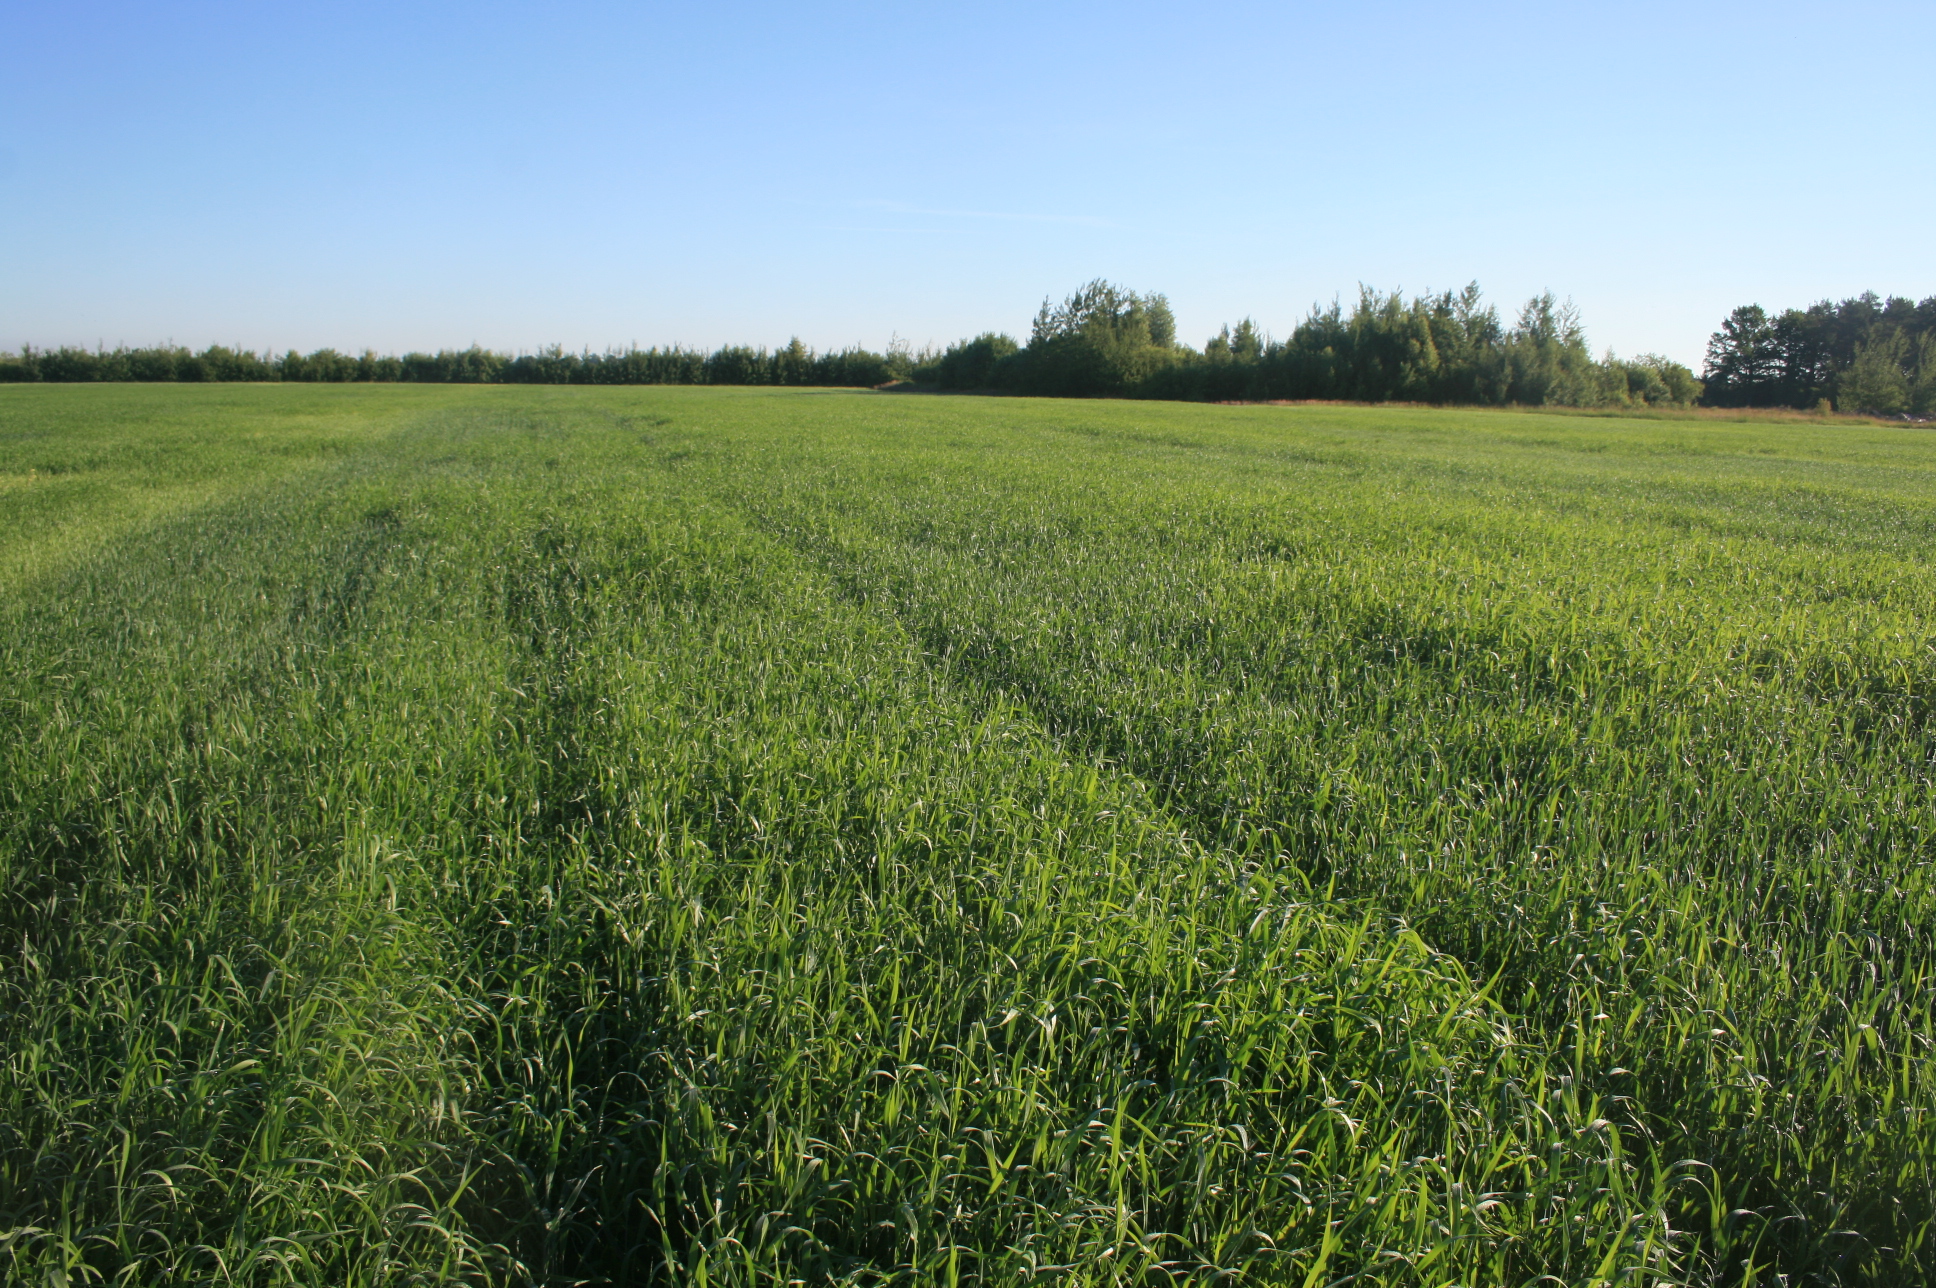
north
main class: Cropland
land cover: Triticale
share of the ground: > 75 %
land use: Agriculture (excluding fallow land and kitchen gardens)
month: June
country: LT
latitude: 55.2876
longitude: 21.4937
